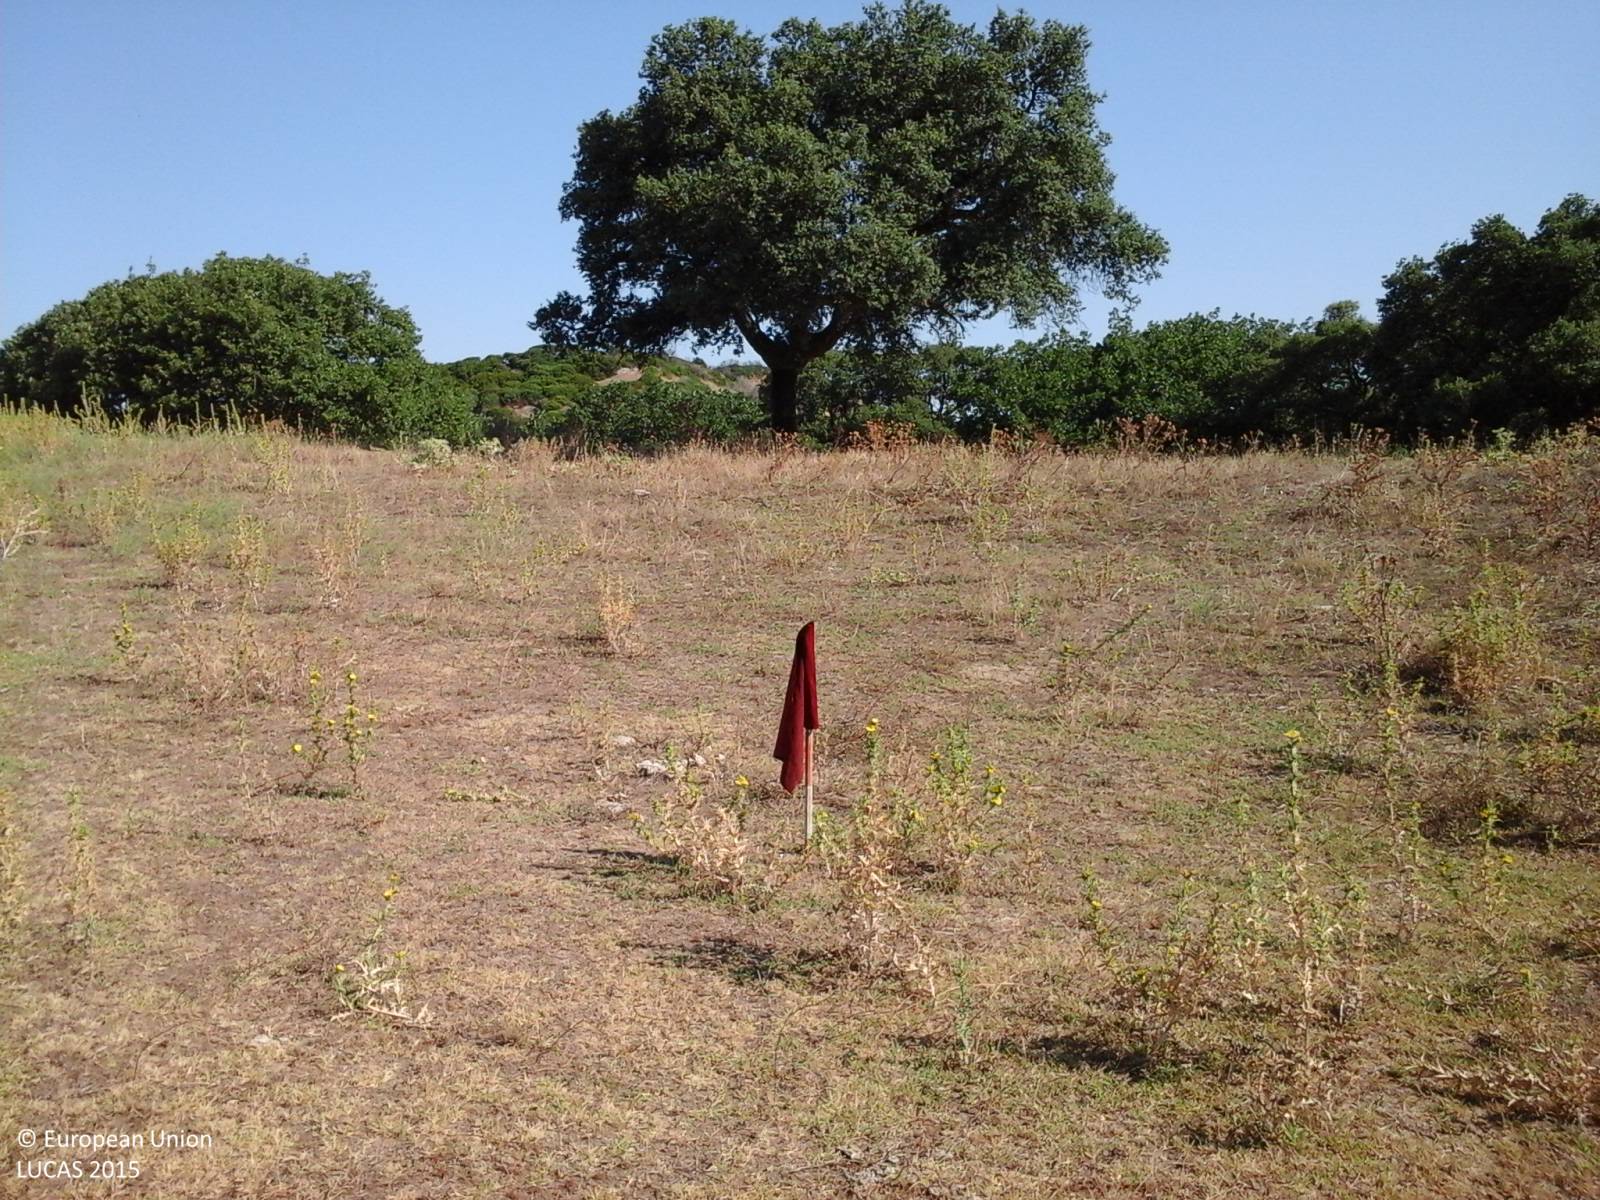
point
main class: Grassland
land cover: Grassland without tree/shrub cover
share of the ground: > 75 %
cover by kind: herbaceous plants 100 %
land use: Agriculture (excluding fallow land and kitchen gardens)
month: July
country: IT
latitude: 40.5860
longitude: 8.8126
